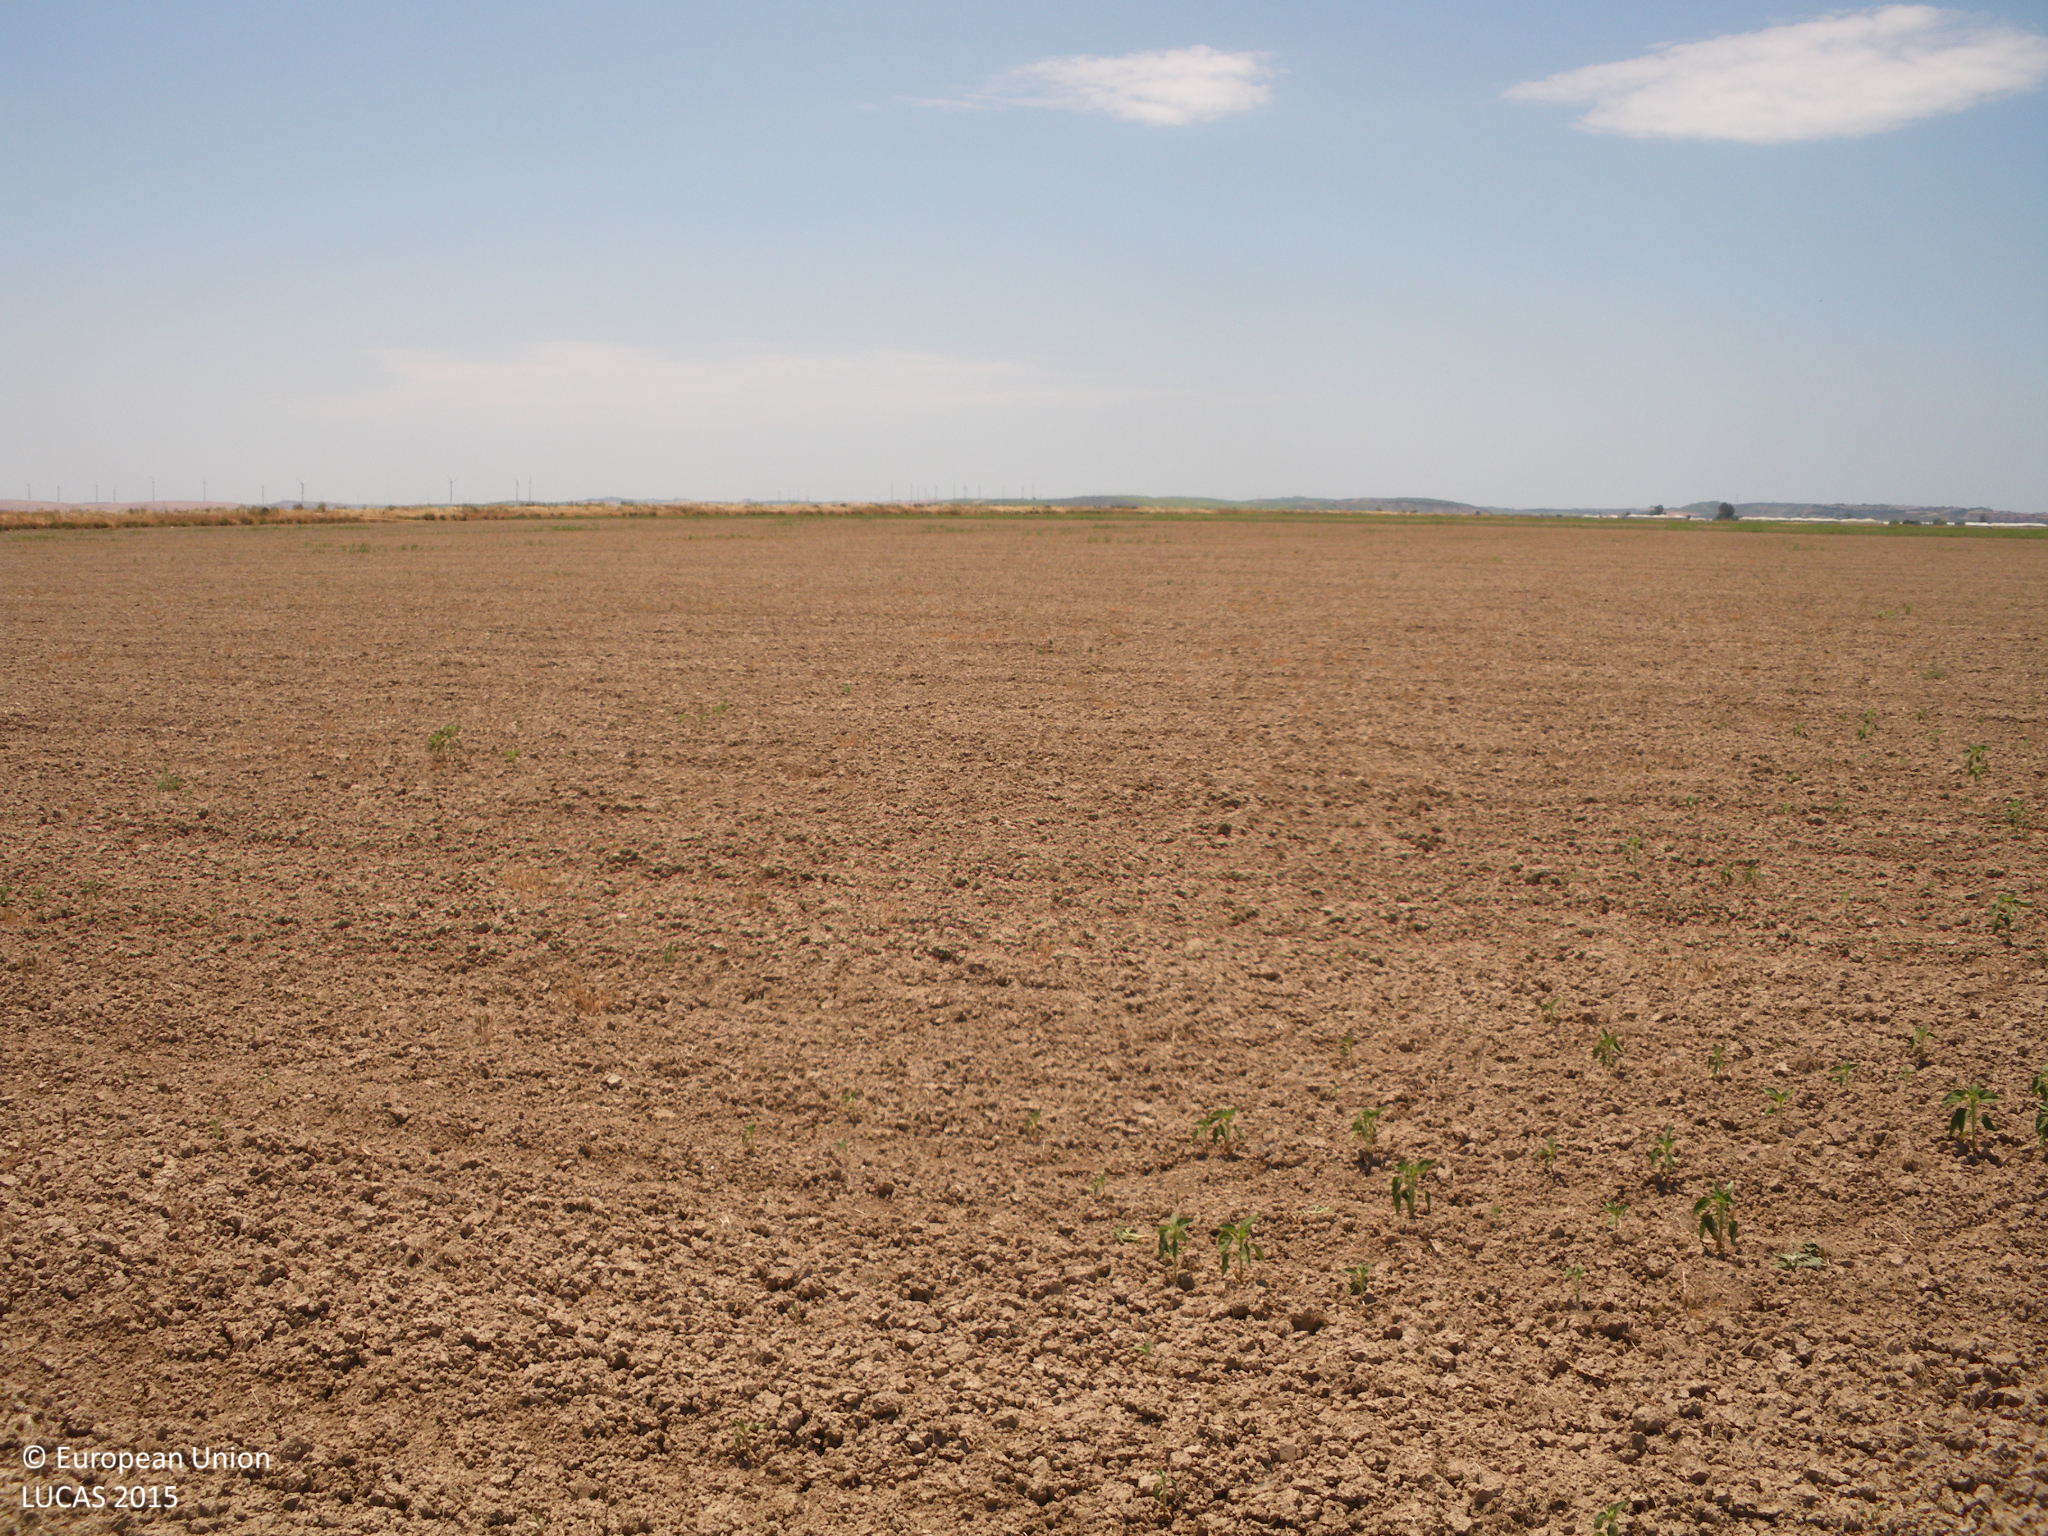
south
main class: Cropland
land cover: Sunflower
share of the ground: < 10 %
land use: Agriculture (excluding fallow land and kitchen gardens)
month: May
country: ES
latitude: 36.8492
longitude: -6.2909
